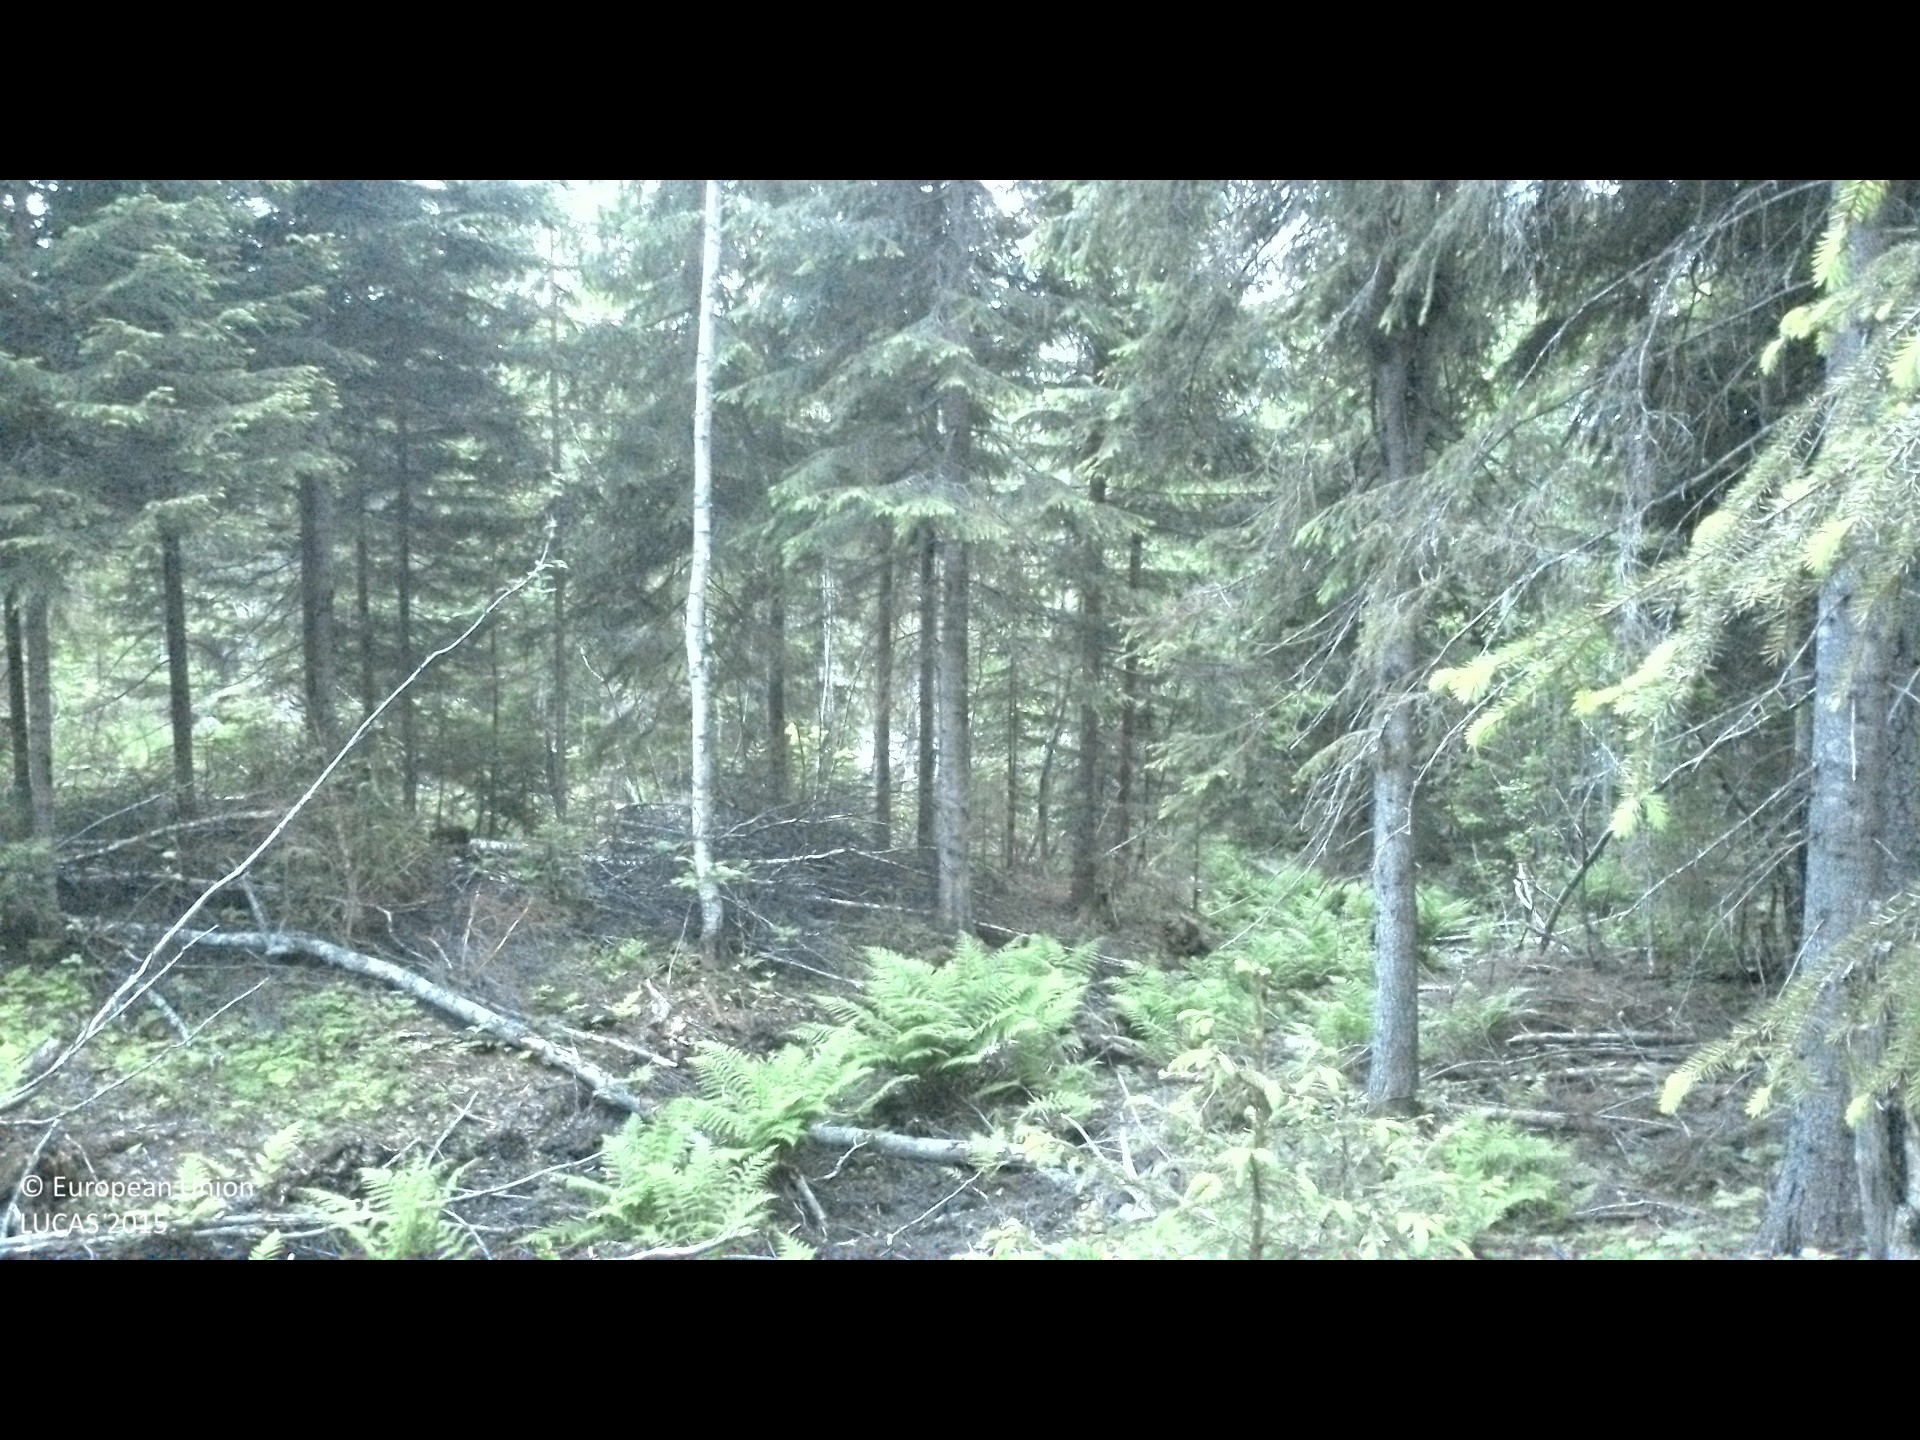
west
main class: Woodland
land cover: Spruce dominated mixed woodland
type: boreal forest
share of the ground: 25 - 50 %
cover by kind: herbaceous plants 40 %, coniferous forest trees 35 %, broadleaved forest trees 15 %, shrubs 5 %, lichens and mosses 5 %
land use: Forestry
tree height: > 5 m
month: June
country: SE
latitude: 62.1890
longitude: 17.1478
